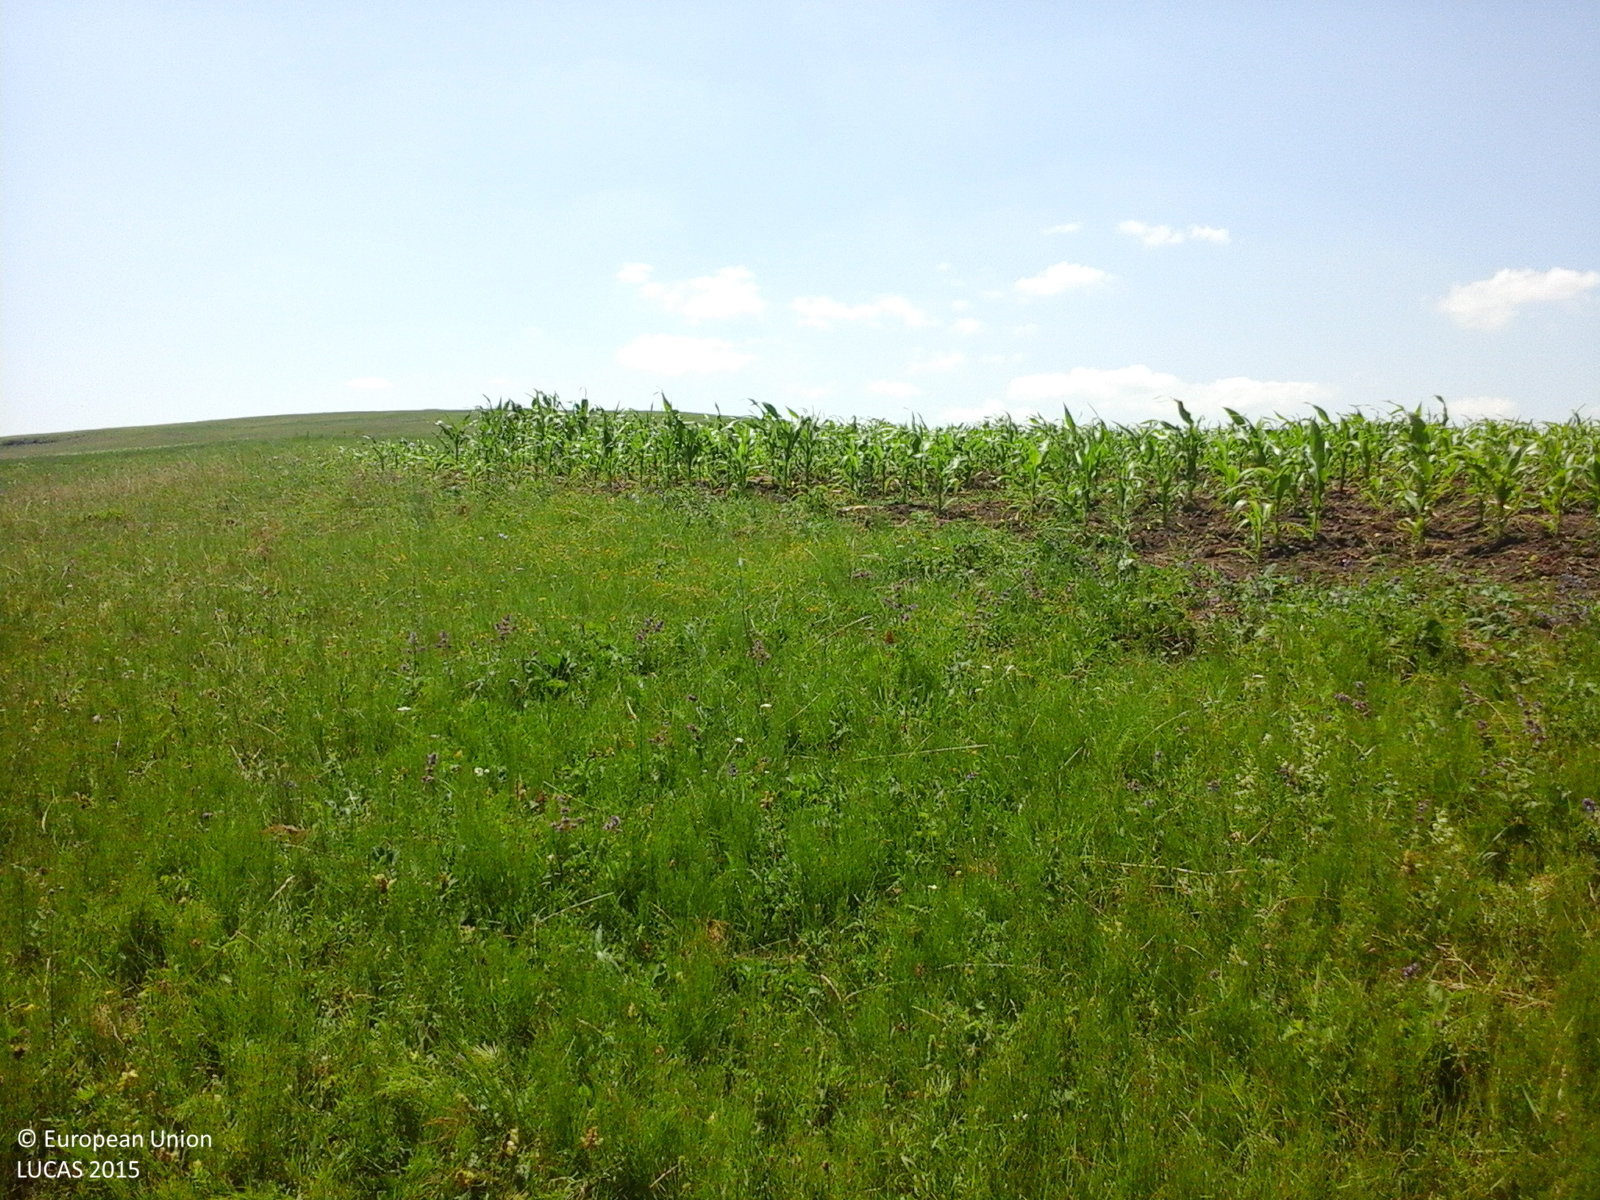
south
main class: Grassland
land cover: Grassland without tree/shrub cover
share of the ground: > 75 %
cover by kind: herbaceous plants 100 %
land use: Agriculture (excluding fallow land and kitchen gardens)
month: June
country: RO
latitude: 47.1720
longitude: 27.1920
